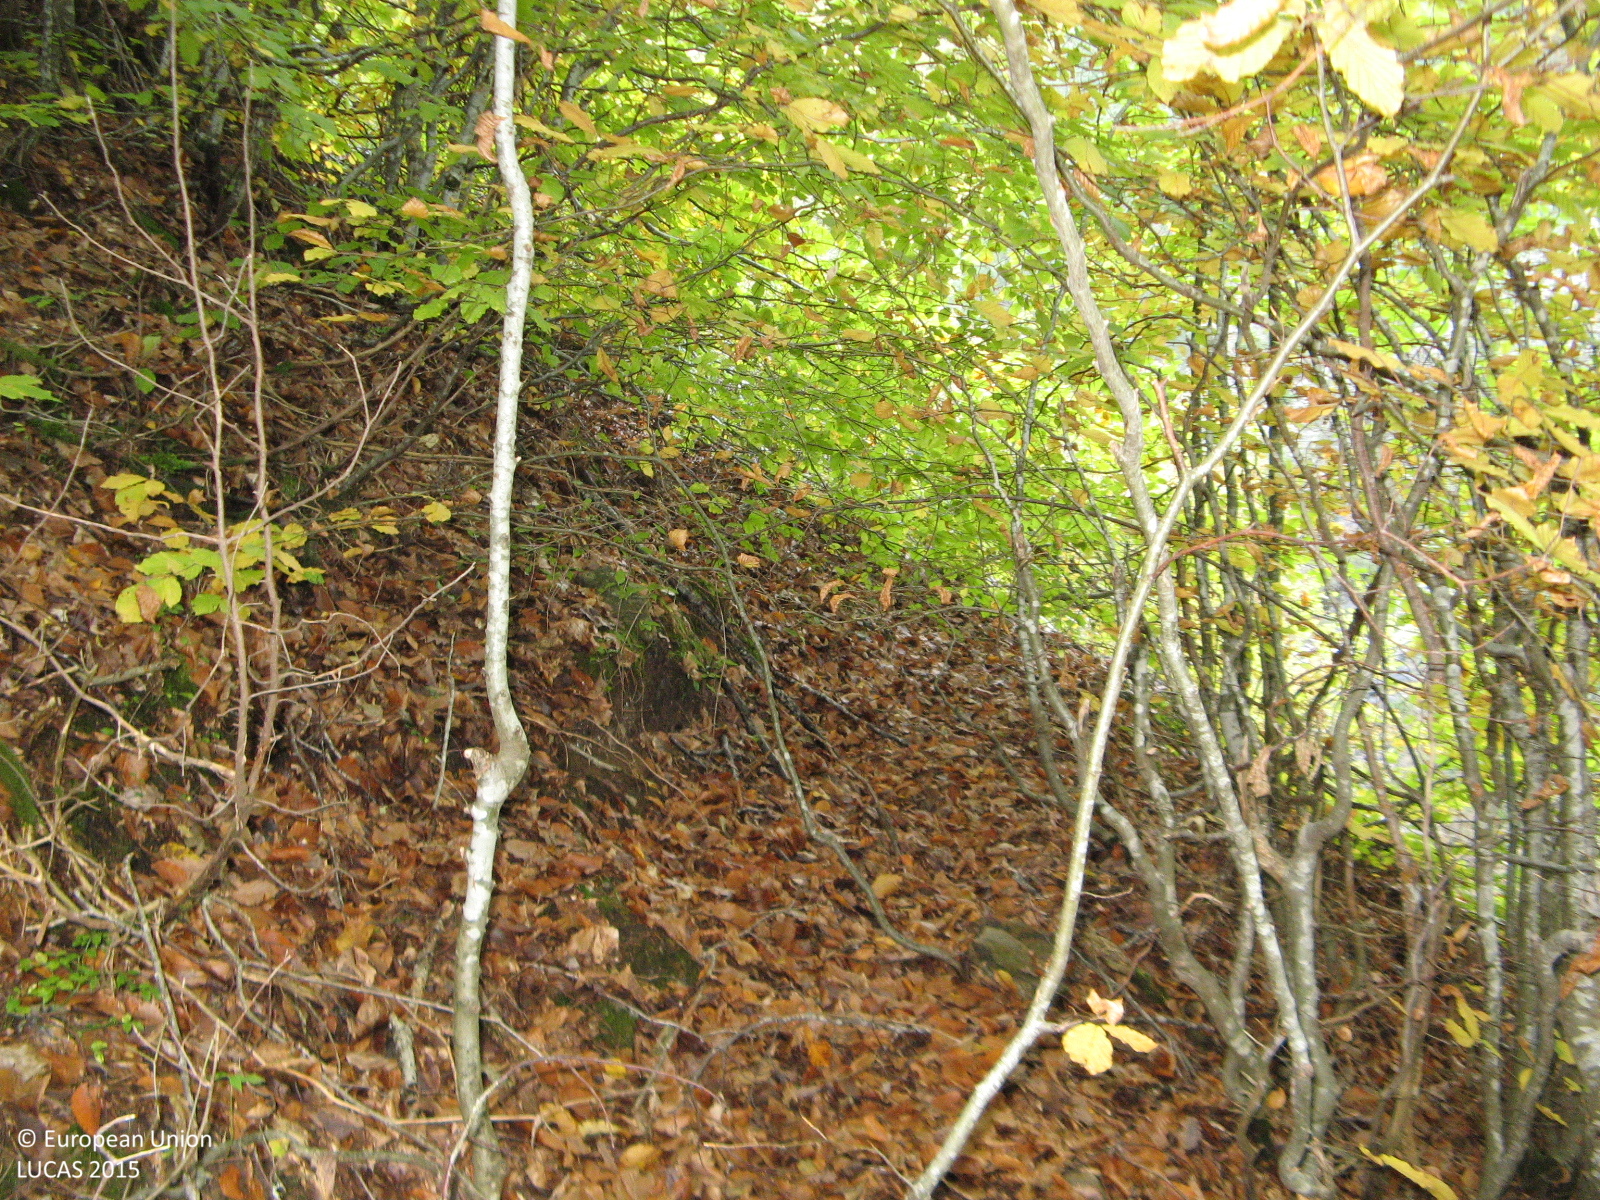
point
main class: Woodland
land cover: Broadleaved woodland
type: mountainous beech forest
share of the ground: > 75 %
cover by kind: broadleaved forest trees 95 %, unconsolidated bare surface 5 %
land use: Forestry
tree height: > 5 m
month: October
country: BG
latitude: 41.4140
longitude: 24.7945
